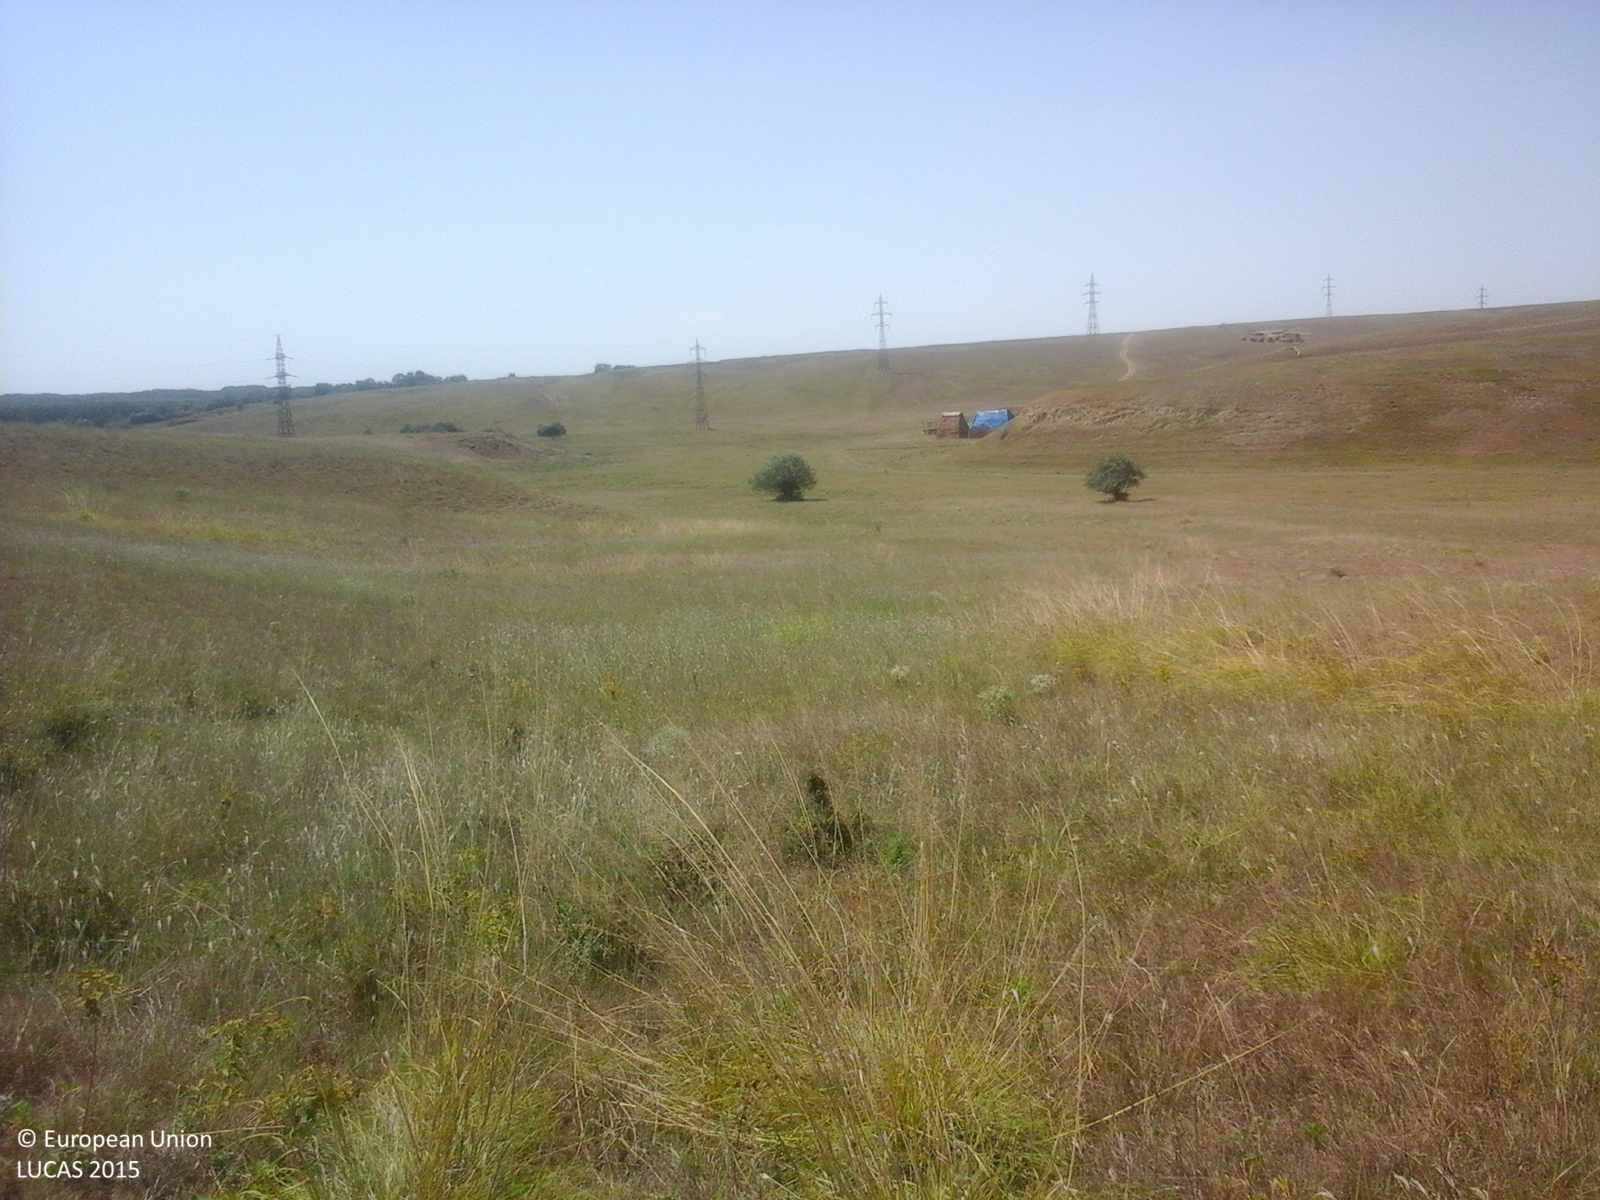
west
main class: Grassland
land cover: Grassland without tree/shrub cover
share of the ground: > 75 %
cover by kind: herbaceous plants 100 %
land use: Agriculture (excluding fallow land and kitchen gardens)
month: August
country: RO
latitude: 44.4939
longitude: 28.1066
